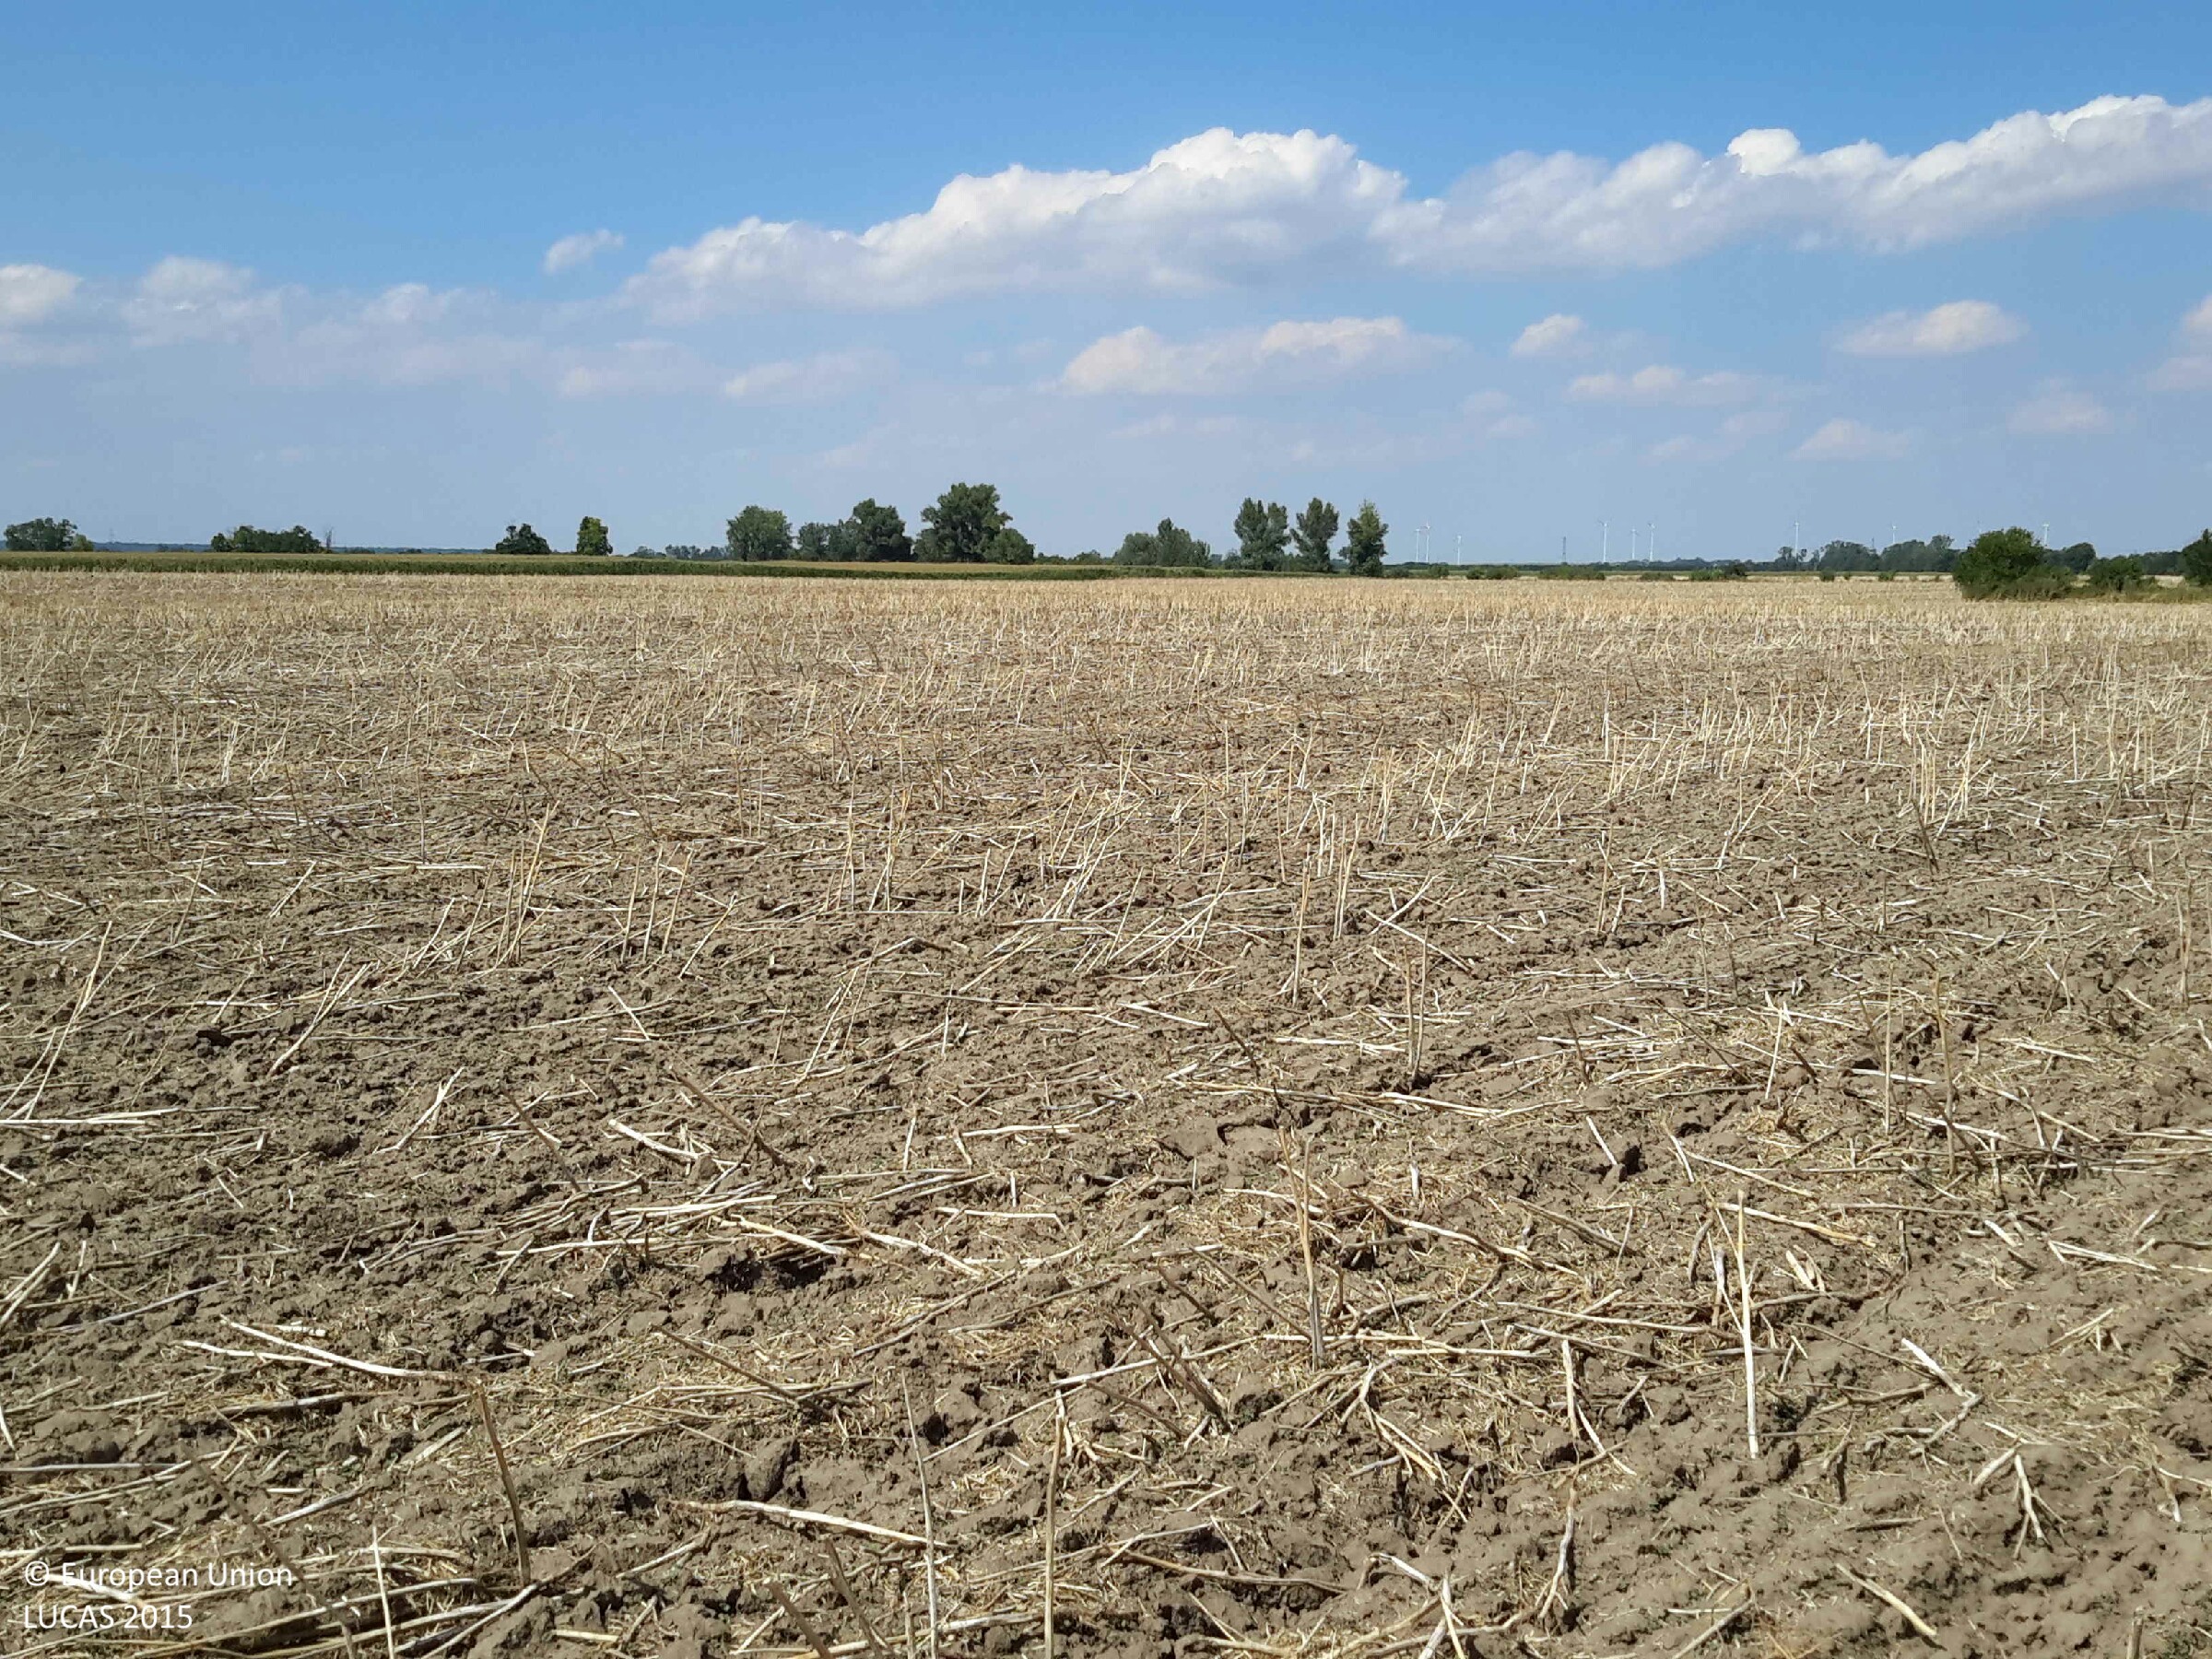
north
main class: Cropland
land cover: Rape and turnip rape
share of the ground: 50 - 75 %
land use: Agriculture (excluding fallow land and kitchen gardens)
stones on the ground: < 10 %
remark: Harvested field
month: July
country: HU
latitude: 47.6003
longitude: 17.8441
